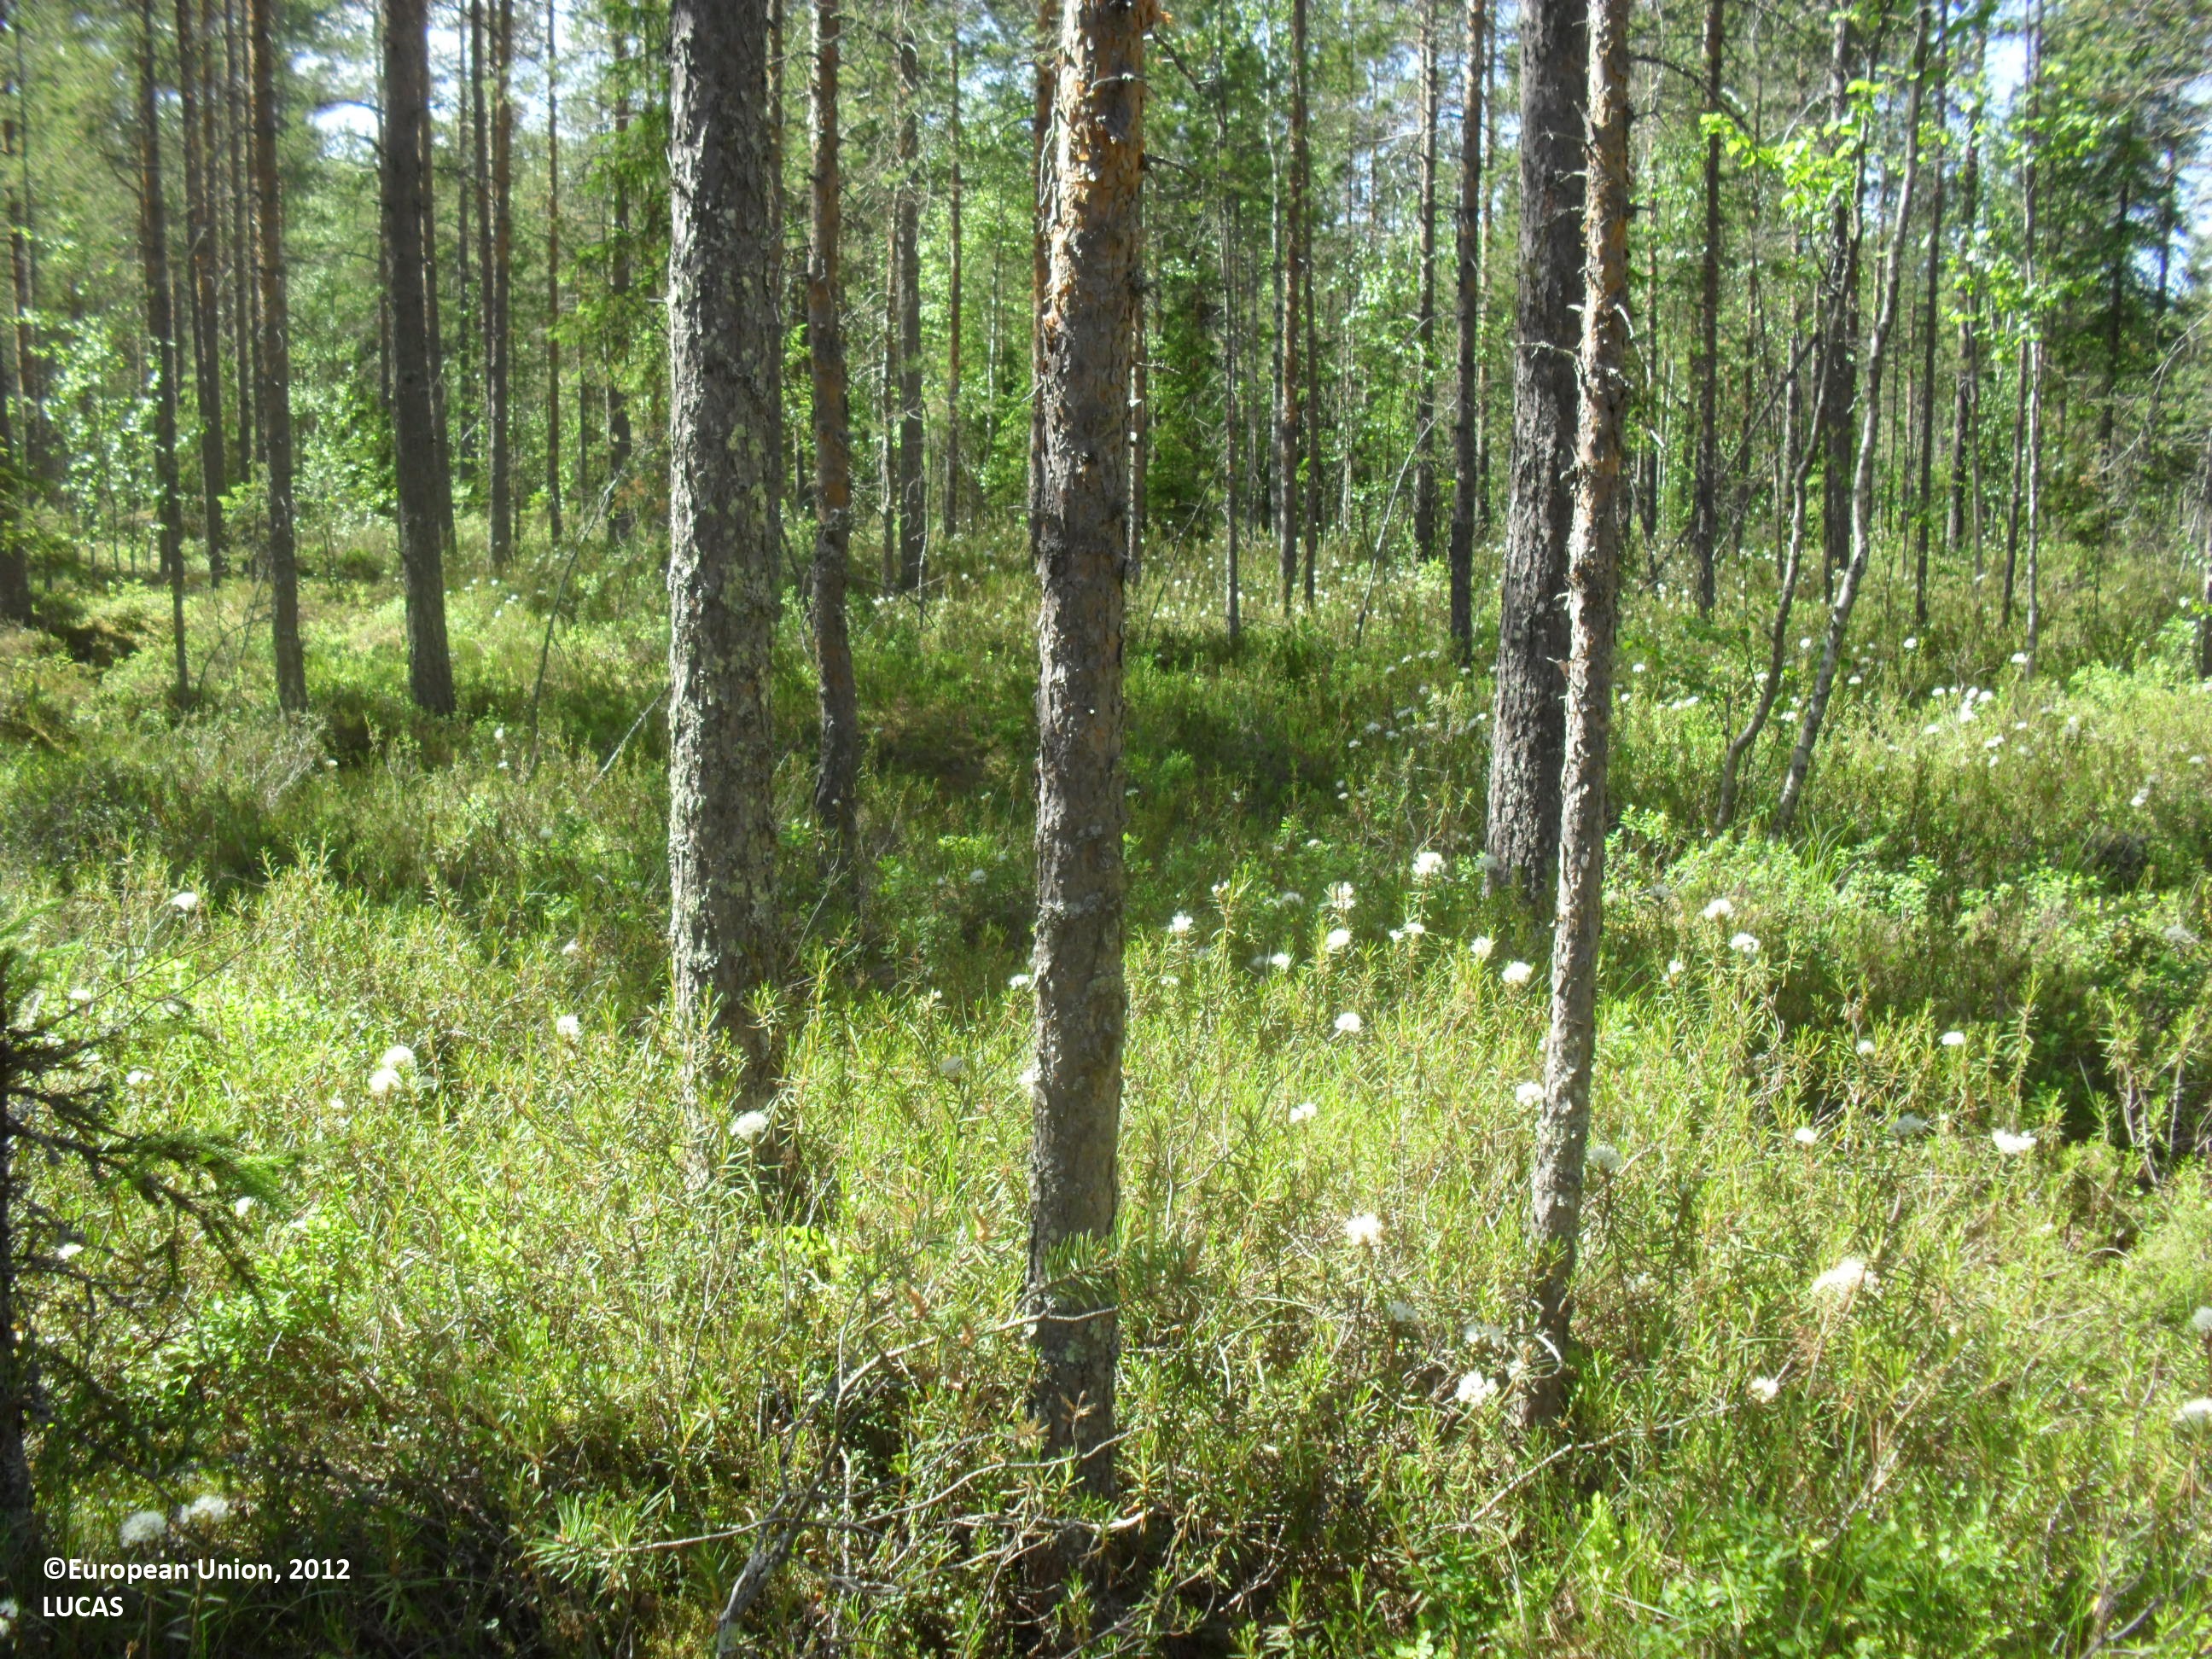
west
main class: Woodland
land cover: Pine dominated mixed woodland
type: boreal forest
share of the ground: 25 - 50 %
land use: Forestry
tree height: > 5 m
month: June
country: FI
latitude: 63.1871
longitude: 23.1543
